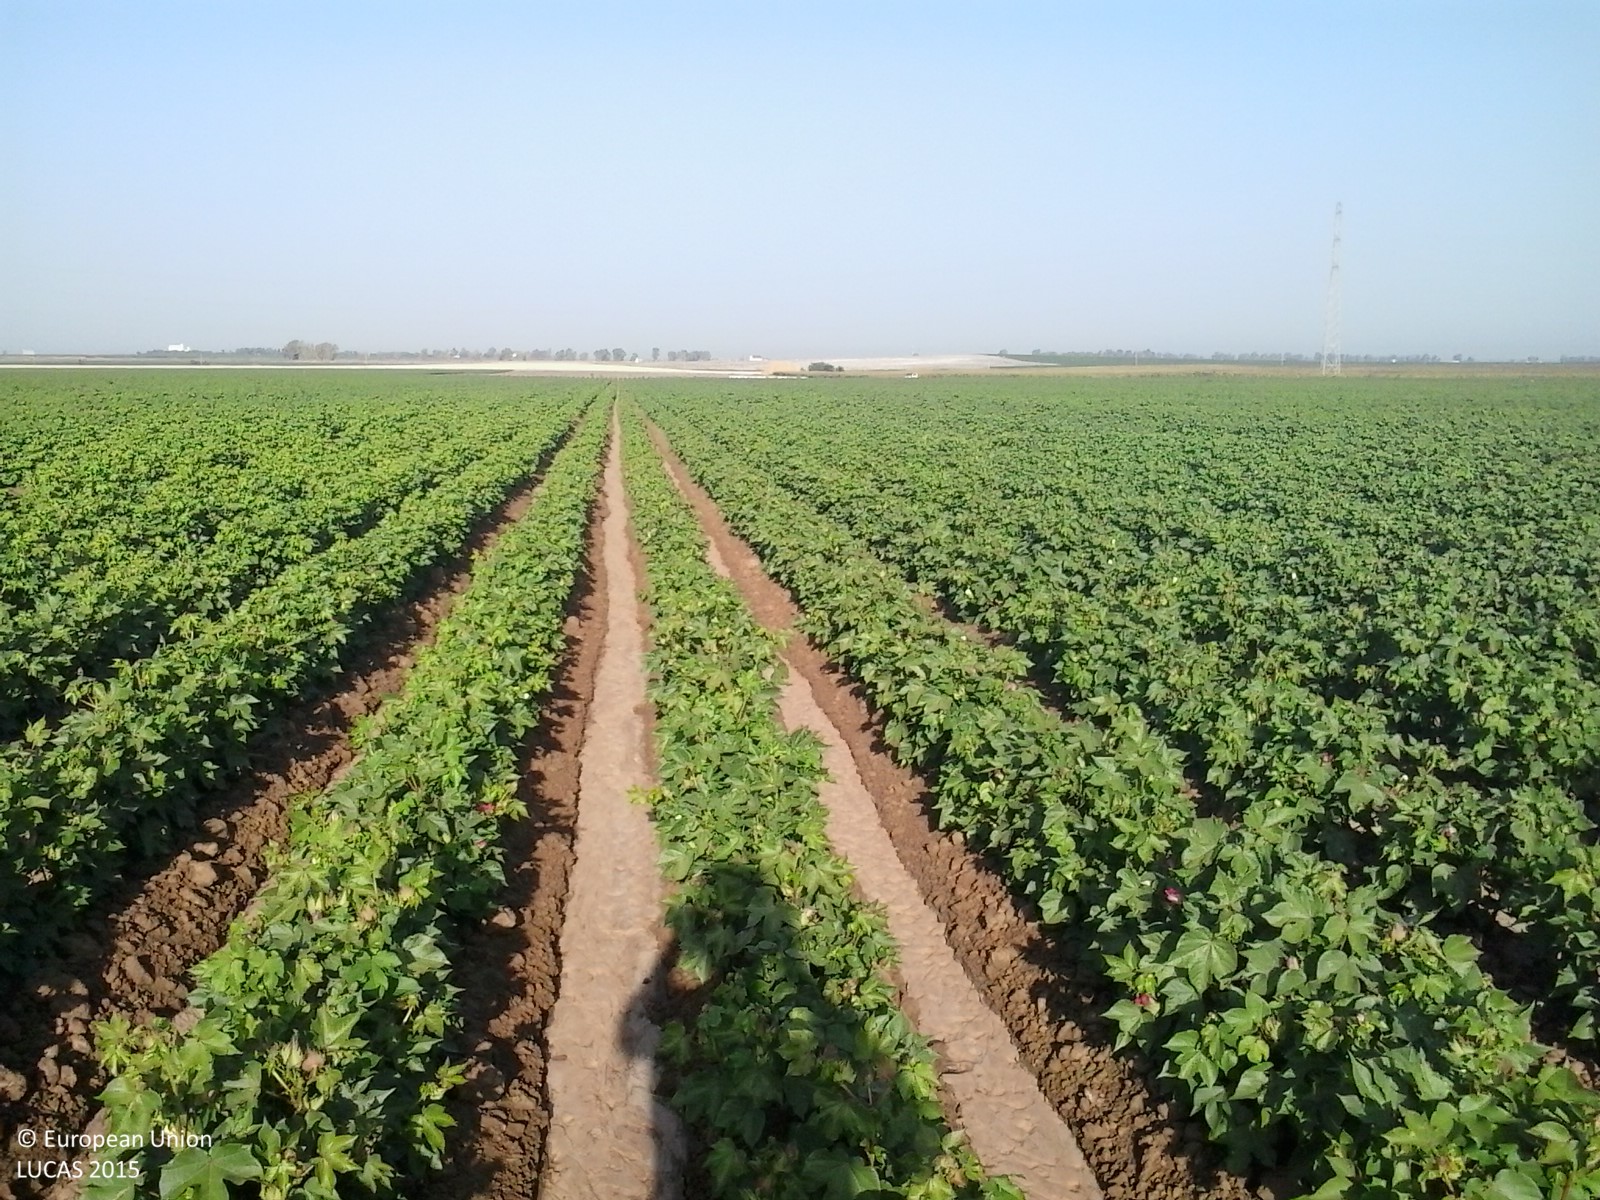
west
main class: Cropland
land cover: Cotton
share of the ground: 25 - 50 %
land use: Agriculture (excluding fallow land and kitchen gardens)
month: July
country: ES
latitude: 37.0958
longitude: -5.8232
